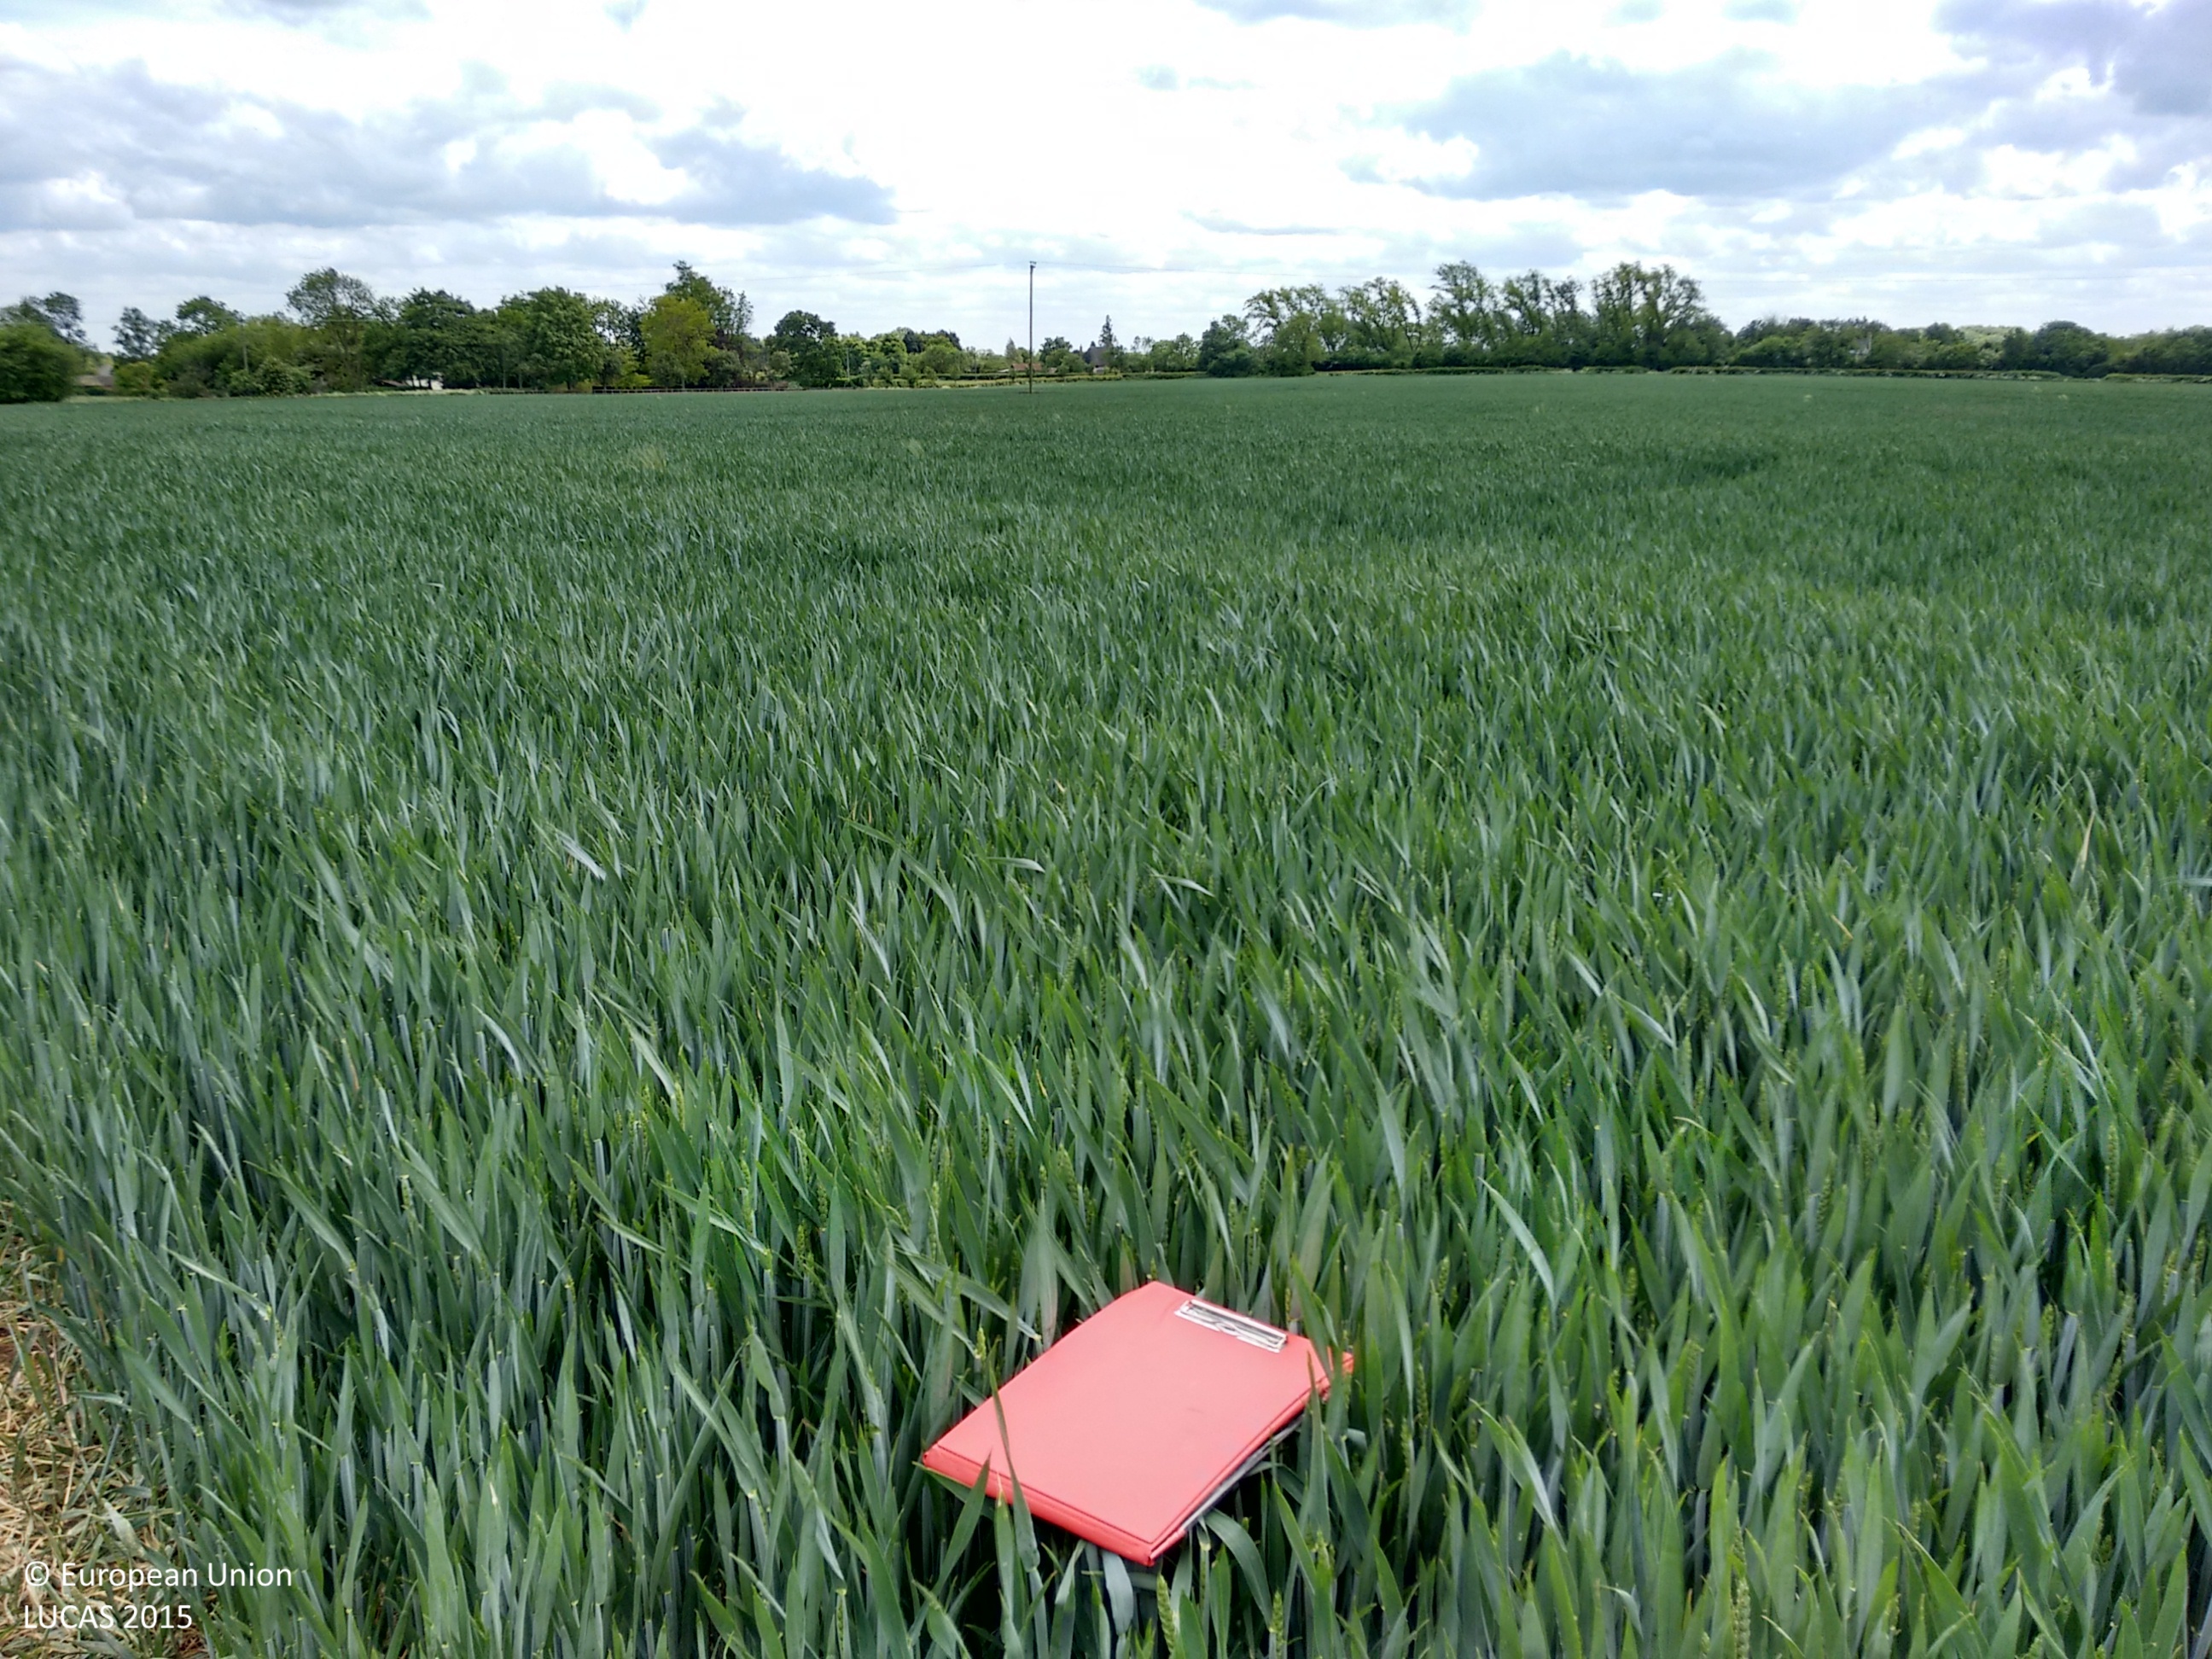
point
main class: Cropland
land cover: Common wheat
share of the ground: > 75 %
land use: Agriculture (excluding fallow land and kitchen gardens)
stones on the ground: < 10 %
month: May
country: GB
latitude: 51.8499
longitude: 0.0525
